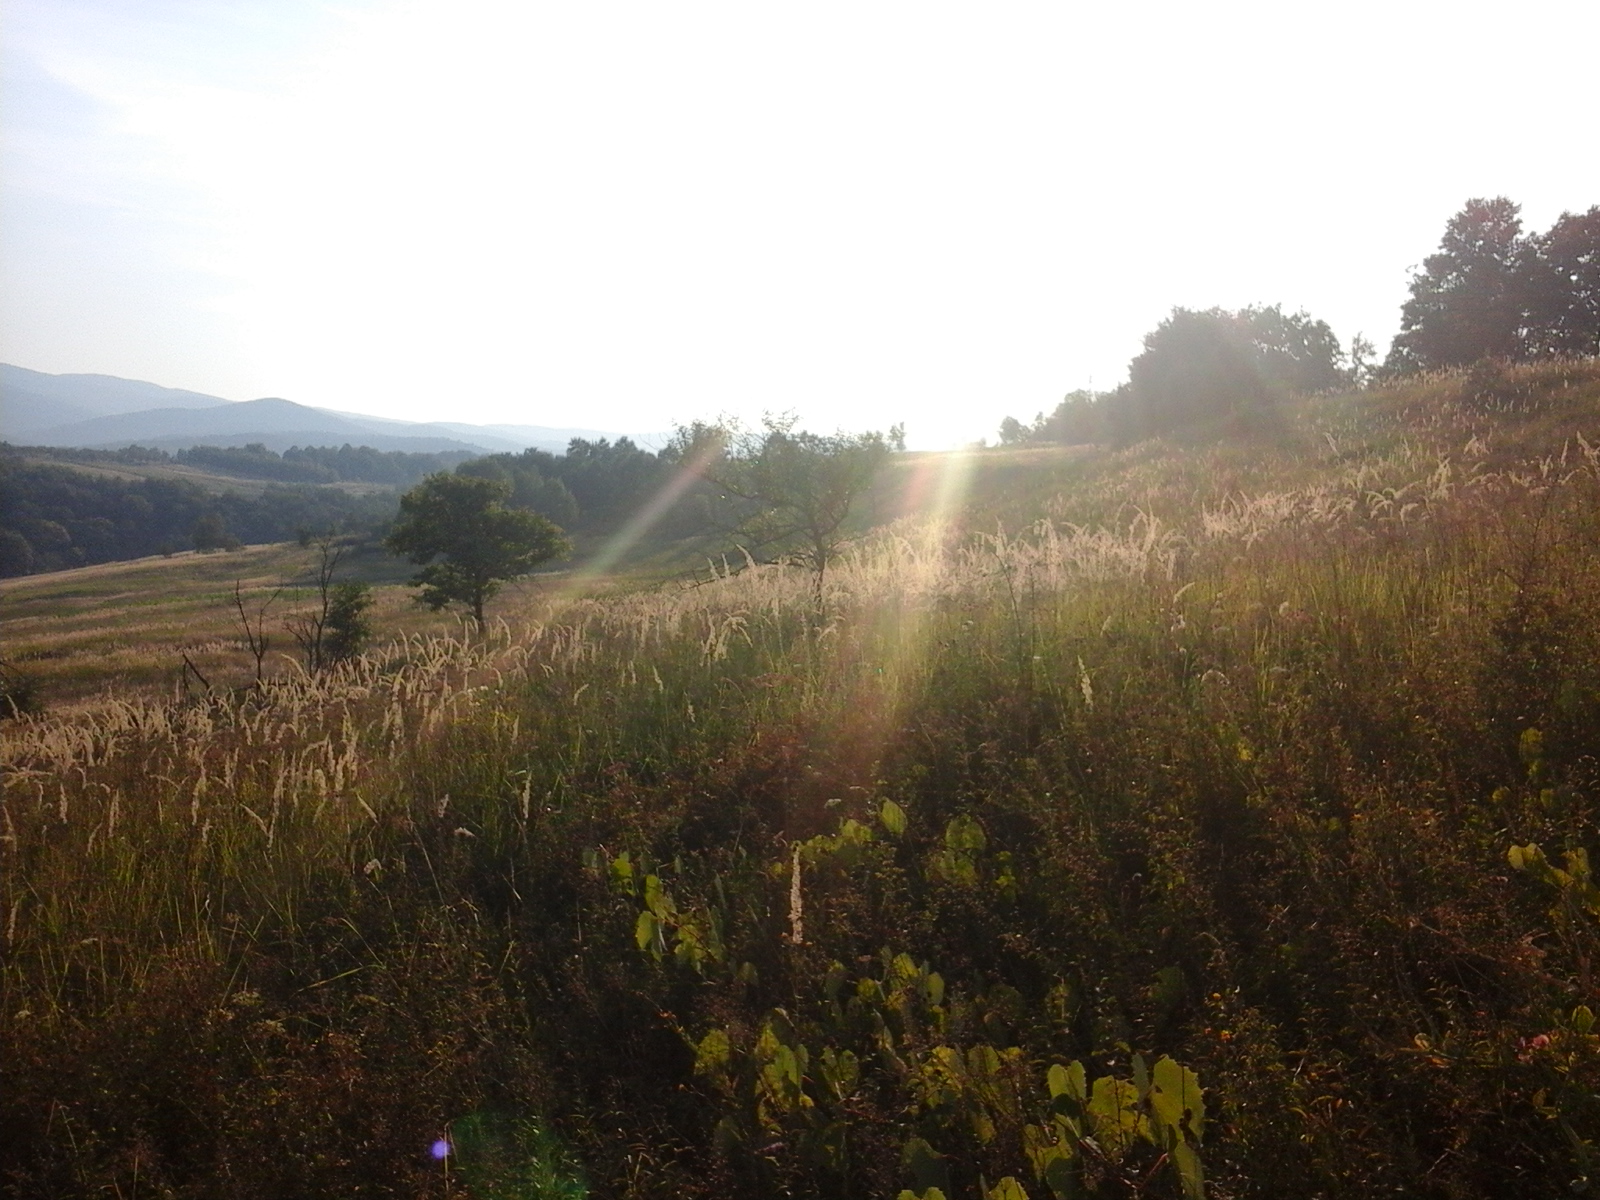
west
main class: Grassland
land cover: Spontaneously vegetated surfaces
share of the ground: > 75 %
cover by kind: herbaceous plants 100 %
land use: Fallow land
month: August
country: RO
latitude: 46.2389
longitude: 22.3022
